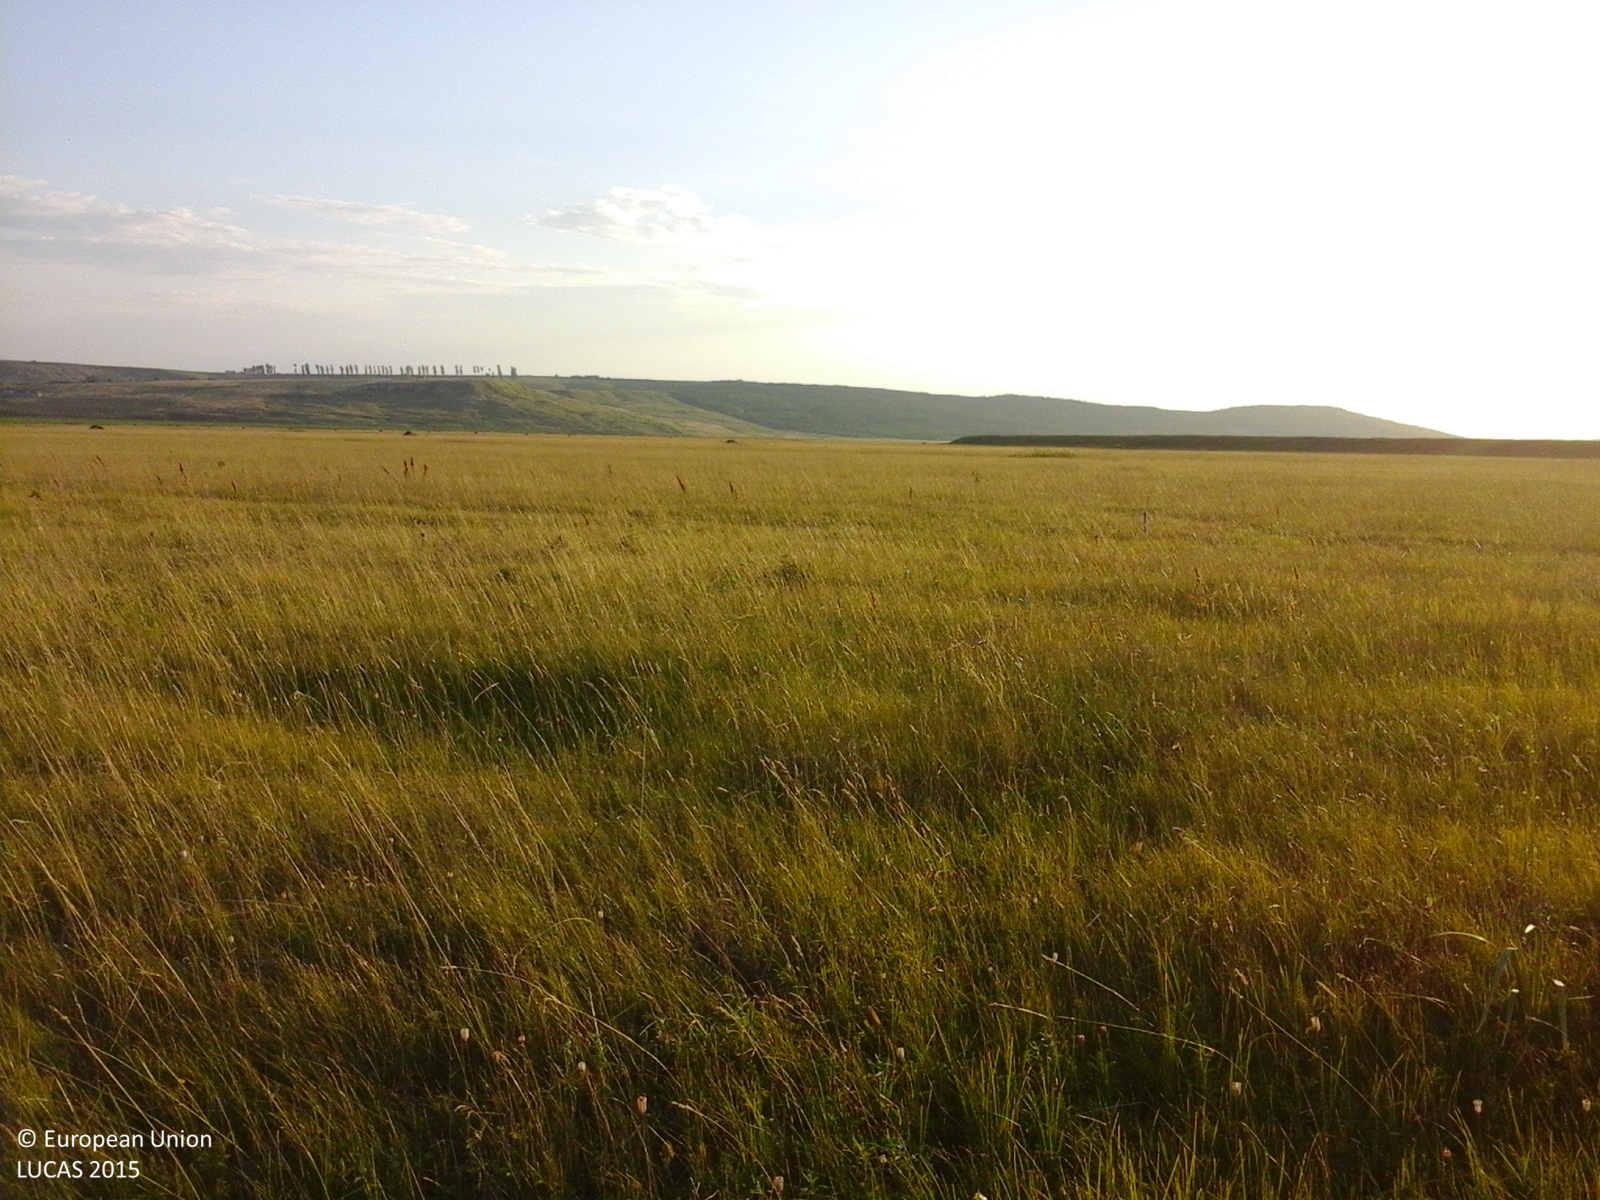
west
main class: Grassland
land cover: Grassland without tree/shrub cover
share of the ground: > 75 %
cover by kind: herbaceous plants 100 %
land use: Agriculture (excluding fallow land and kitchen gardens)
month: June
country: RO
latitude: 47.3129
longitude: 27.4580
